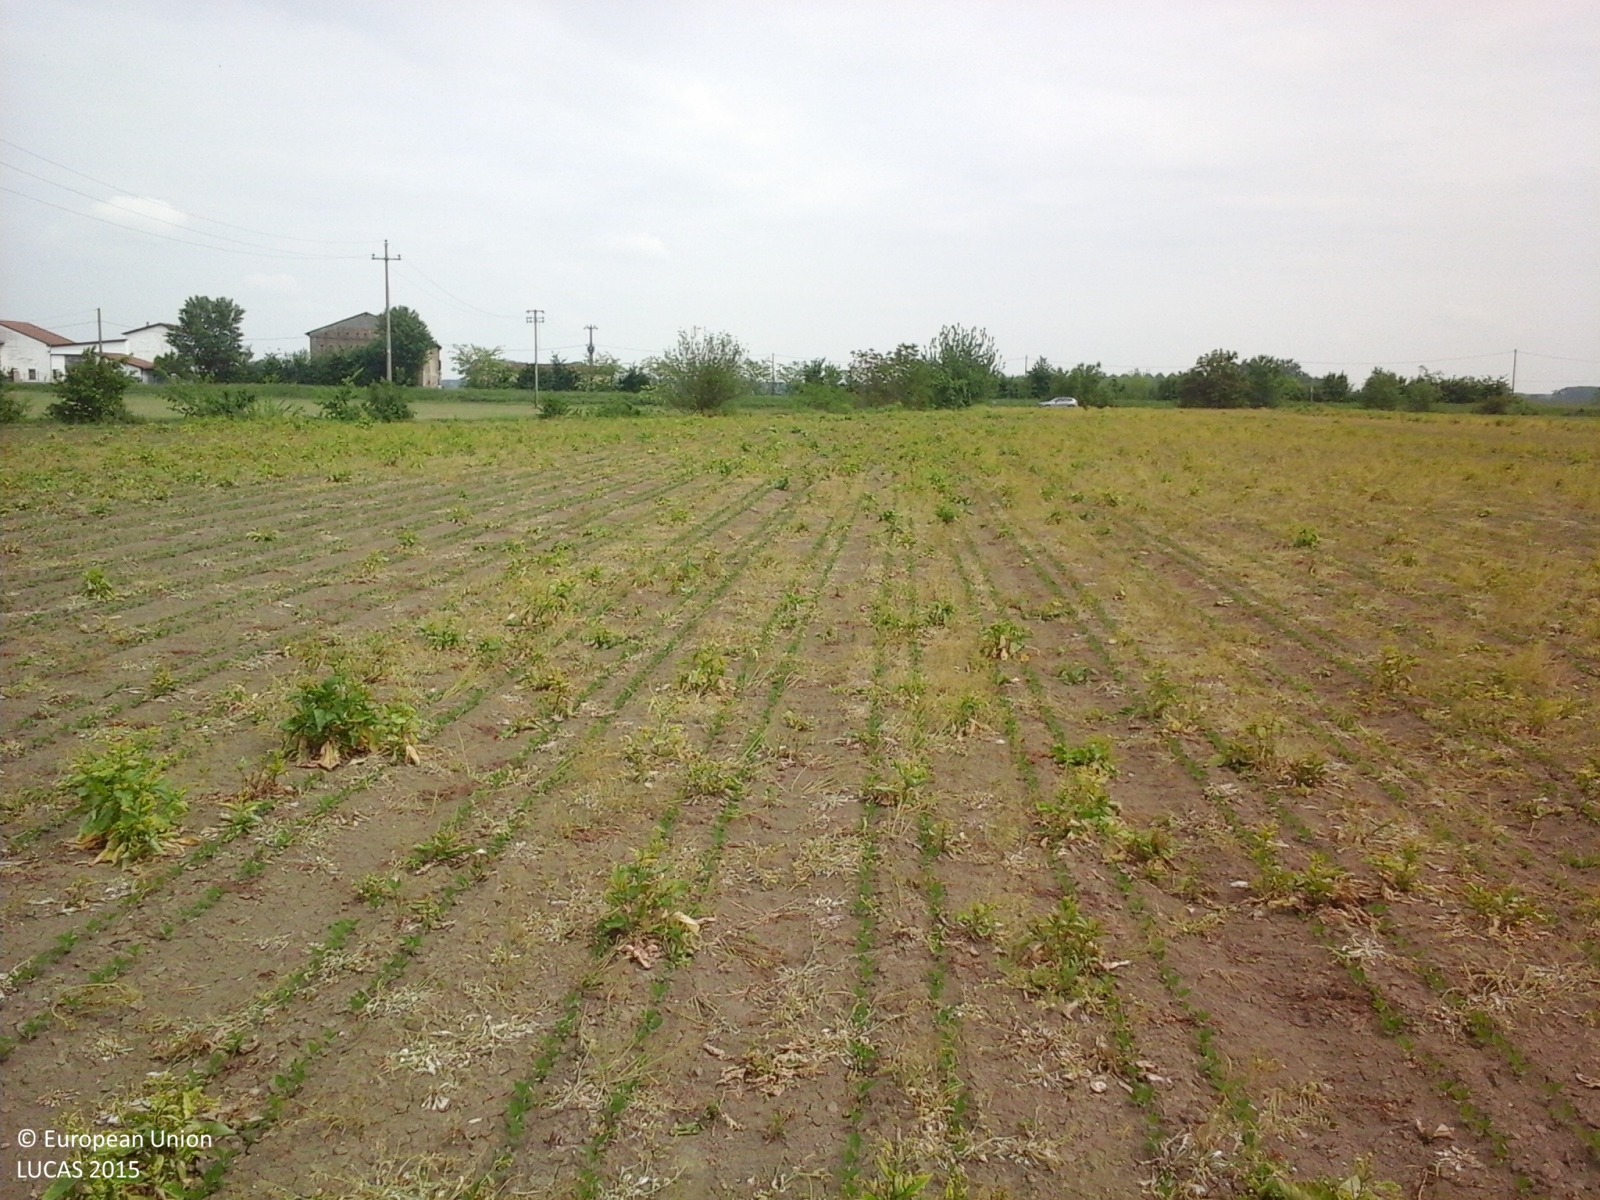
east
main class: Cropland
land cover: Soya
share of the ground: 10 - 25 %
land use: Agriculture (excluding fallow land and kitchen gardens)
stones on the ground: < 10 %
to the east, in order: Soya; Electric lines; Soya; Grass margins; Electric lines; Ditches and canals; Tracks; Maize; Tracks; Inland fresh running water; Grass margins; Artificial constructions in urban areas
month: May
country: IT
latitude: 44.9979
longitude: 10.6204
